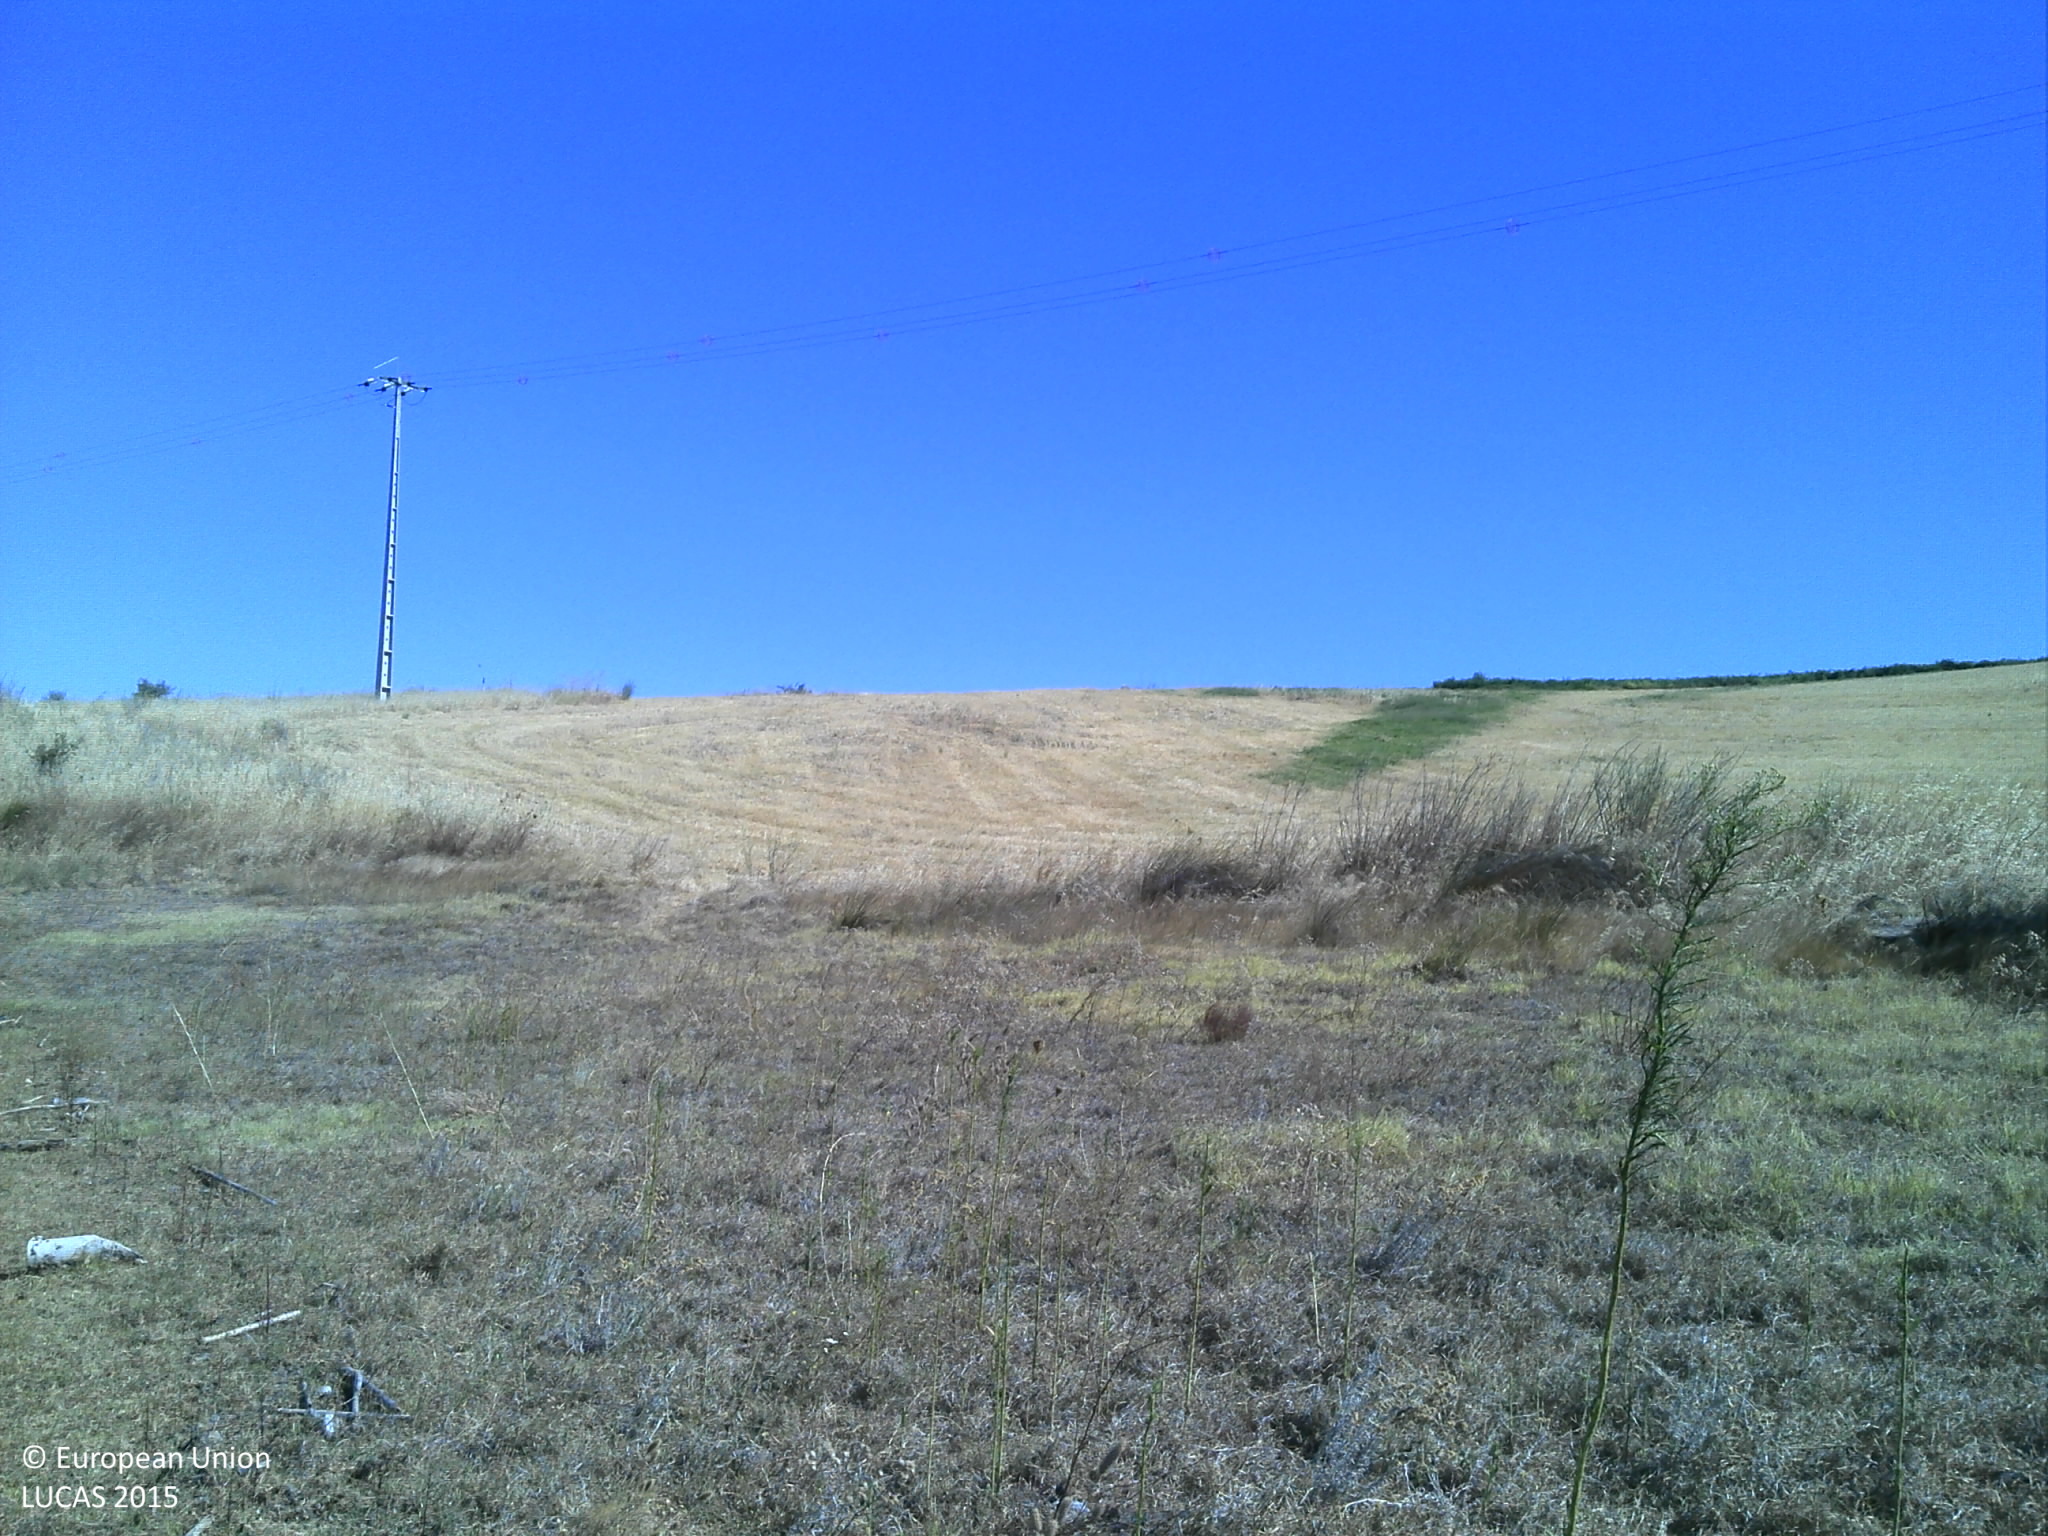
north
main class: Grassland
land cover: Grassland without tree/shrub cover
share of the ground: 10 - 25 %
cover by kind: unconsolidated bare surface 85 %, herbaceous plants 15 %
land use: Agriculture (excluding fallow land and kitchen gardens)
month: July
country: PT
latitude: 39.0237
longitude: -7.1363
